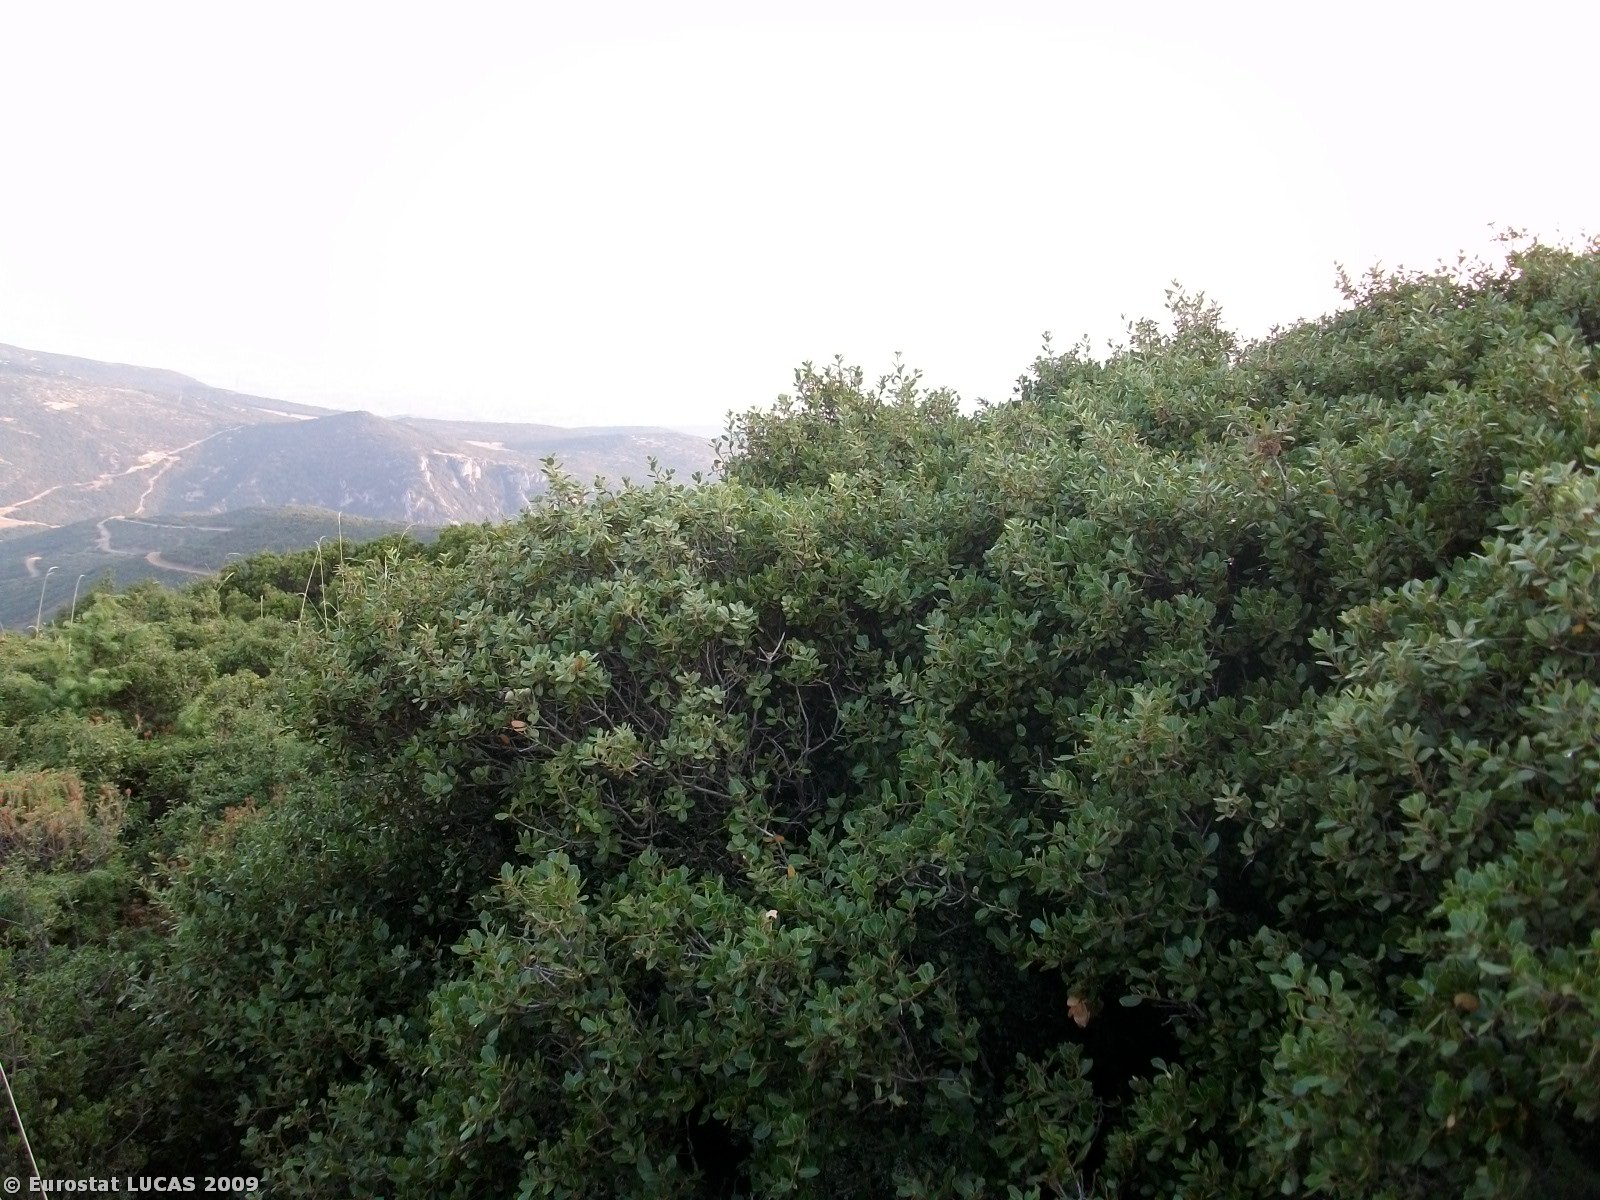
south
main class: Shrubland
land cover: Shrubland without tree cover
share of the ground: > 75 %
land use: Unused
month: August
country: GR
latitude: 38.9758
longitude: 22.4596
